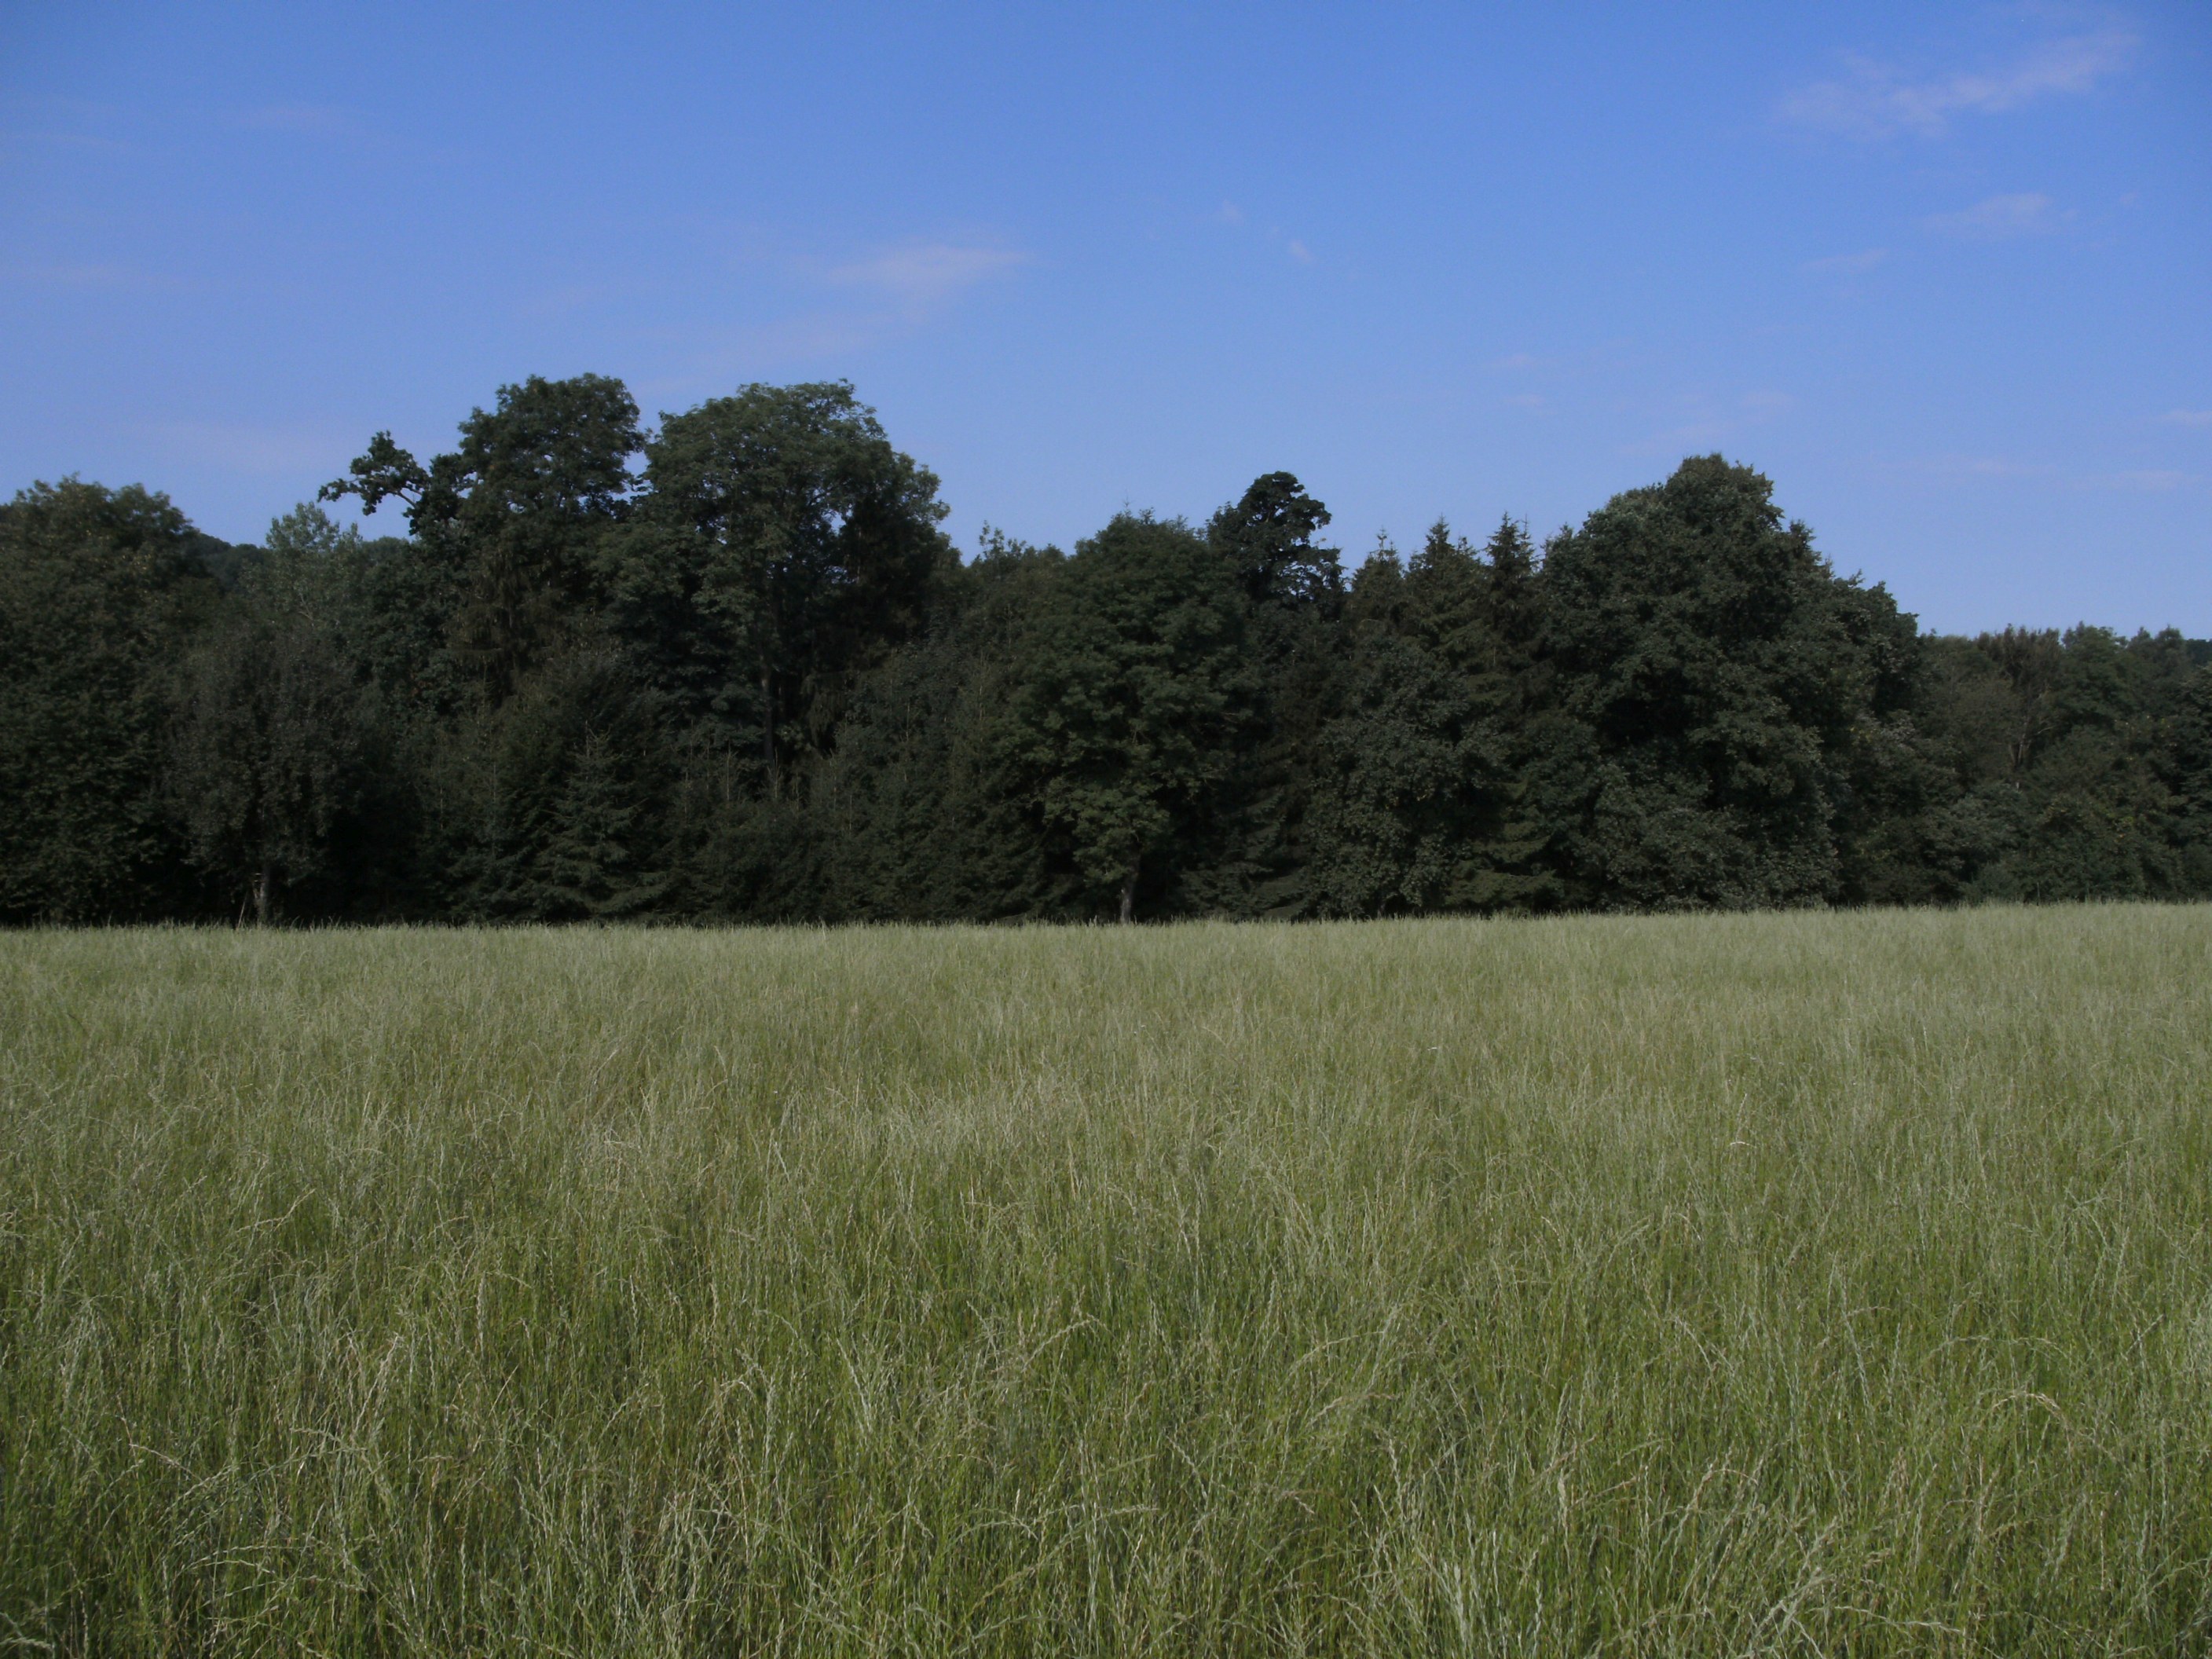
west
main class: Grassland
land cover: Grassland without tree/shrub cover
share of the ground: > 75 %
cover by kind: herbaceous plants 100 %
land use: Agriculture (excluding fallow land and kitchen gardens)
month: July
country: AT
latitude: 48.2576
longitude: 13.5149
